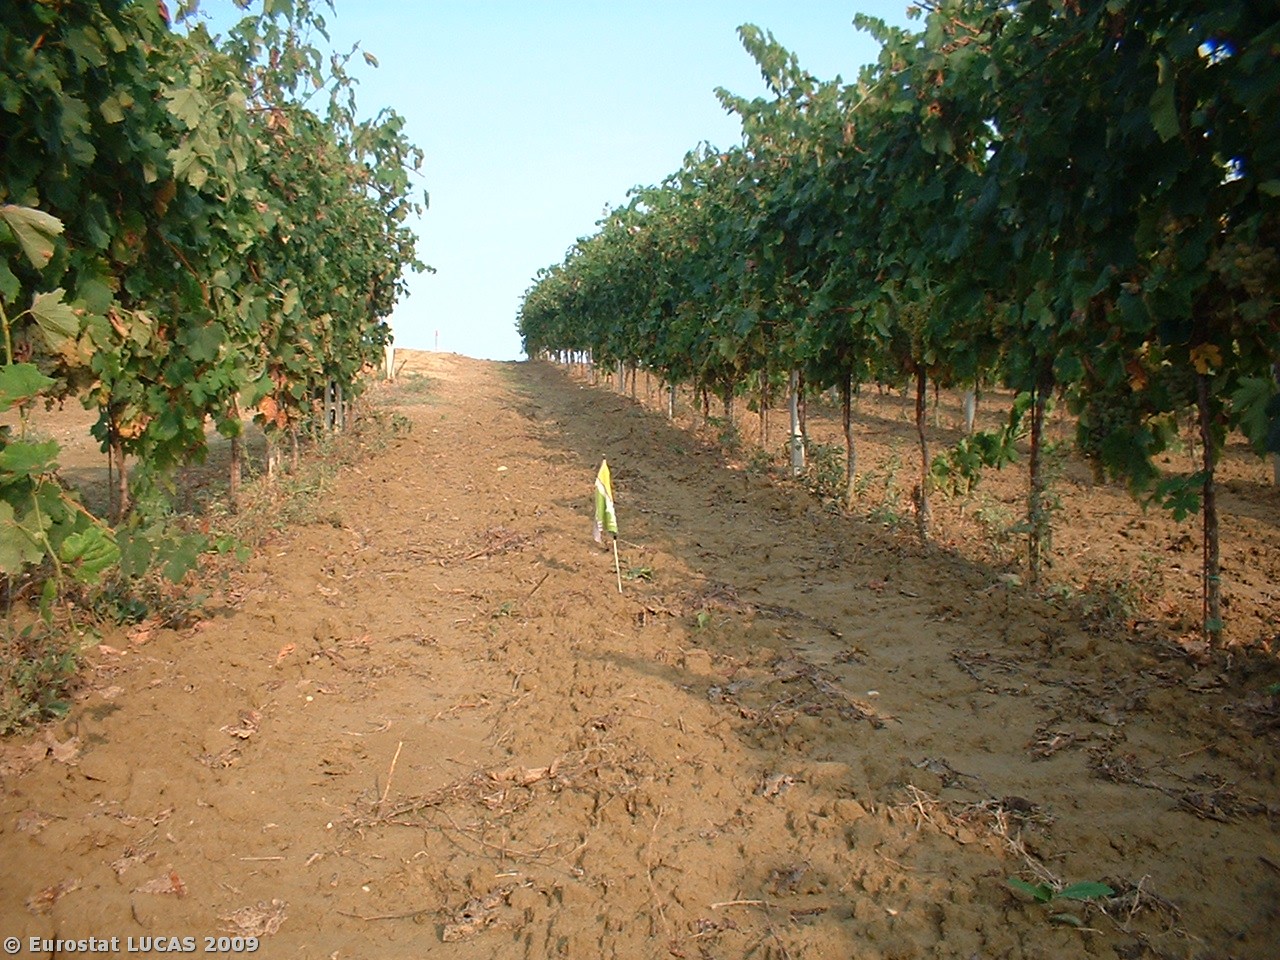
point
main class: Cropland
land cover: Vineyards
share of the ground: 25 - 50 %
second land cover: Bare land
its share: > 75 %
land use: Agriculture (excluding fallow land and kitchen gardens)
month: June
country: IT
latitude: 42.8928
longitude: 13.7246
